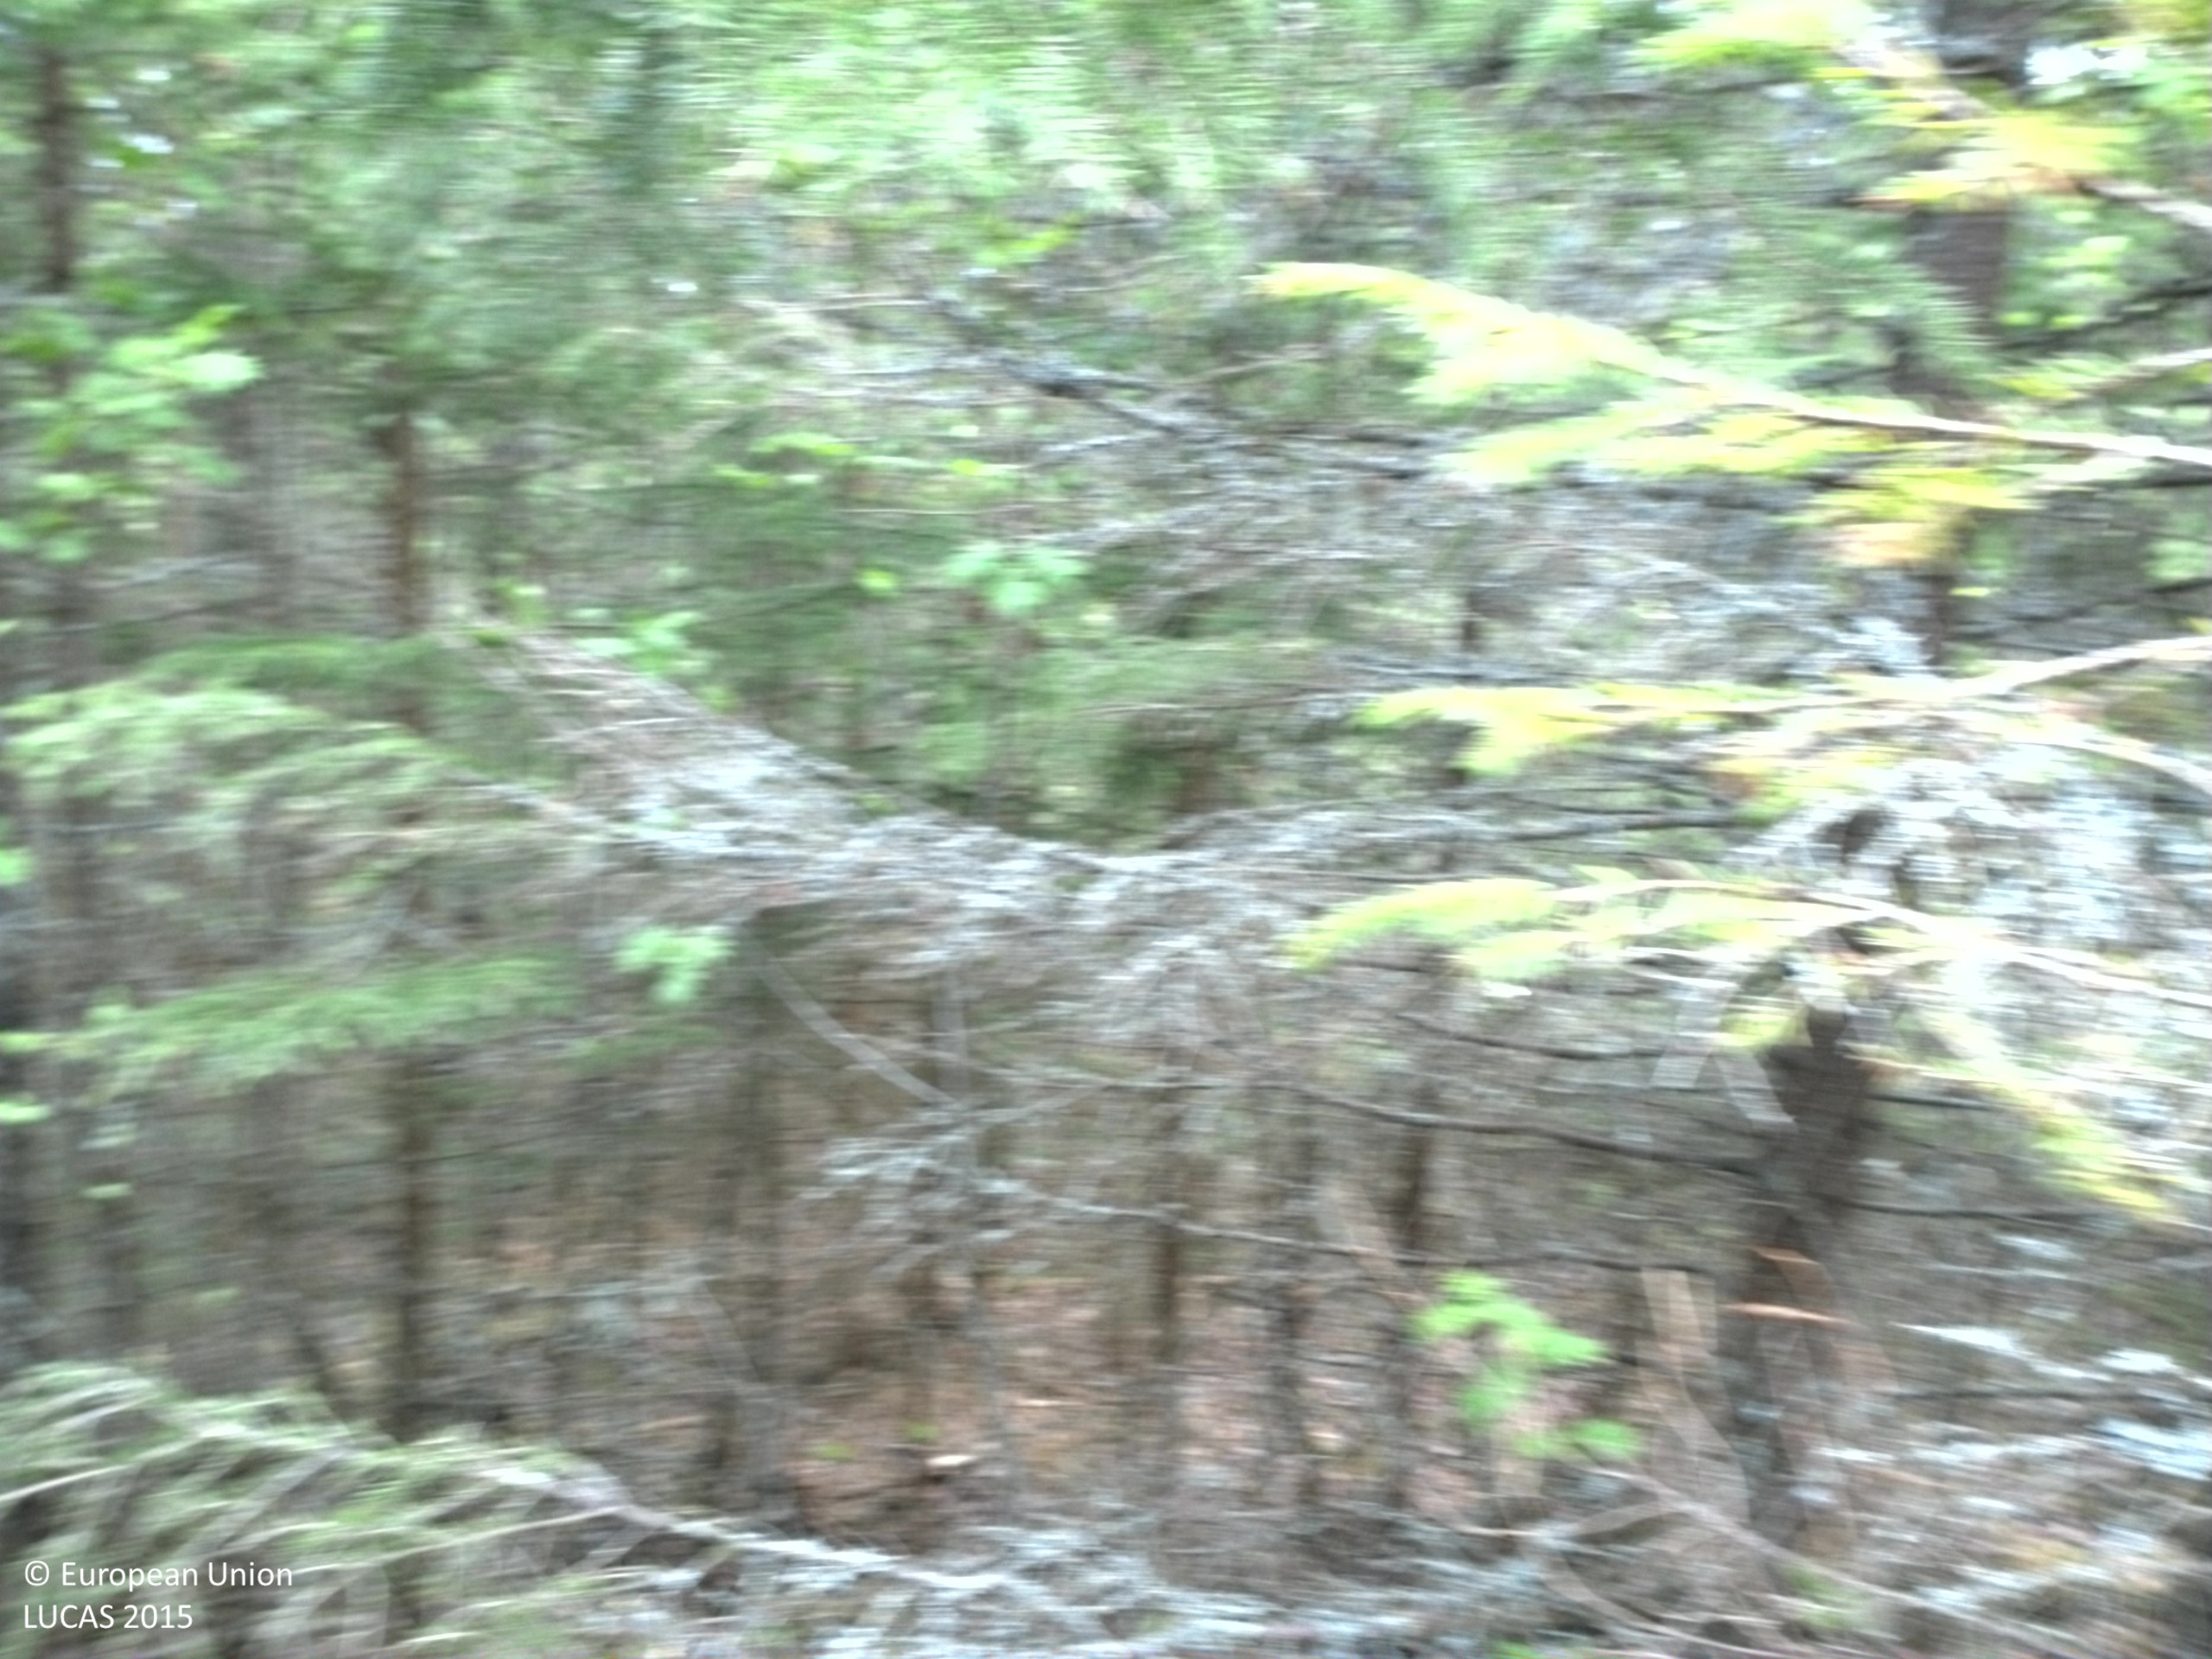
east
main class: Woodland
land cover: Spruce dominated coniferous woodland
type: boreal forest
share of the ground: > 75 %
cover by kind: coniferous forest trees 75 %, lichens and mosses 15 %, shrubs 10 %
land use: Forestry
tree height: > 5 m
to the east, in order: Spruce dominated coniferous woodland; Paved roads, cycling and walking lanes; Grass margins; Broadleaved woodland; Electric lines; Broadleaved woodland; Grass margins; Inland fresh water bodies; Grass margins; Other mixed woodland; Grassland without tree/shrub cover
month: May
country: SE
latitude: 62.8742
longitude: 17.9408
